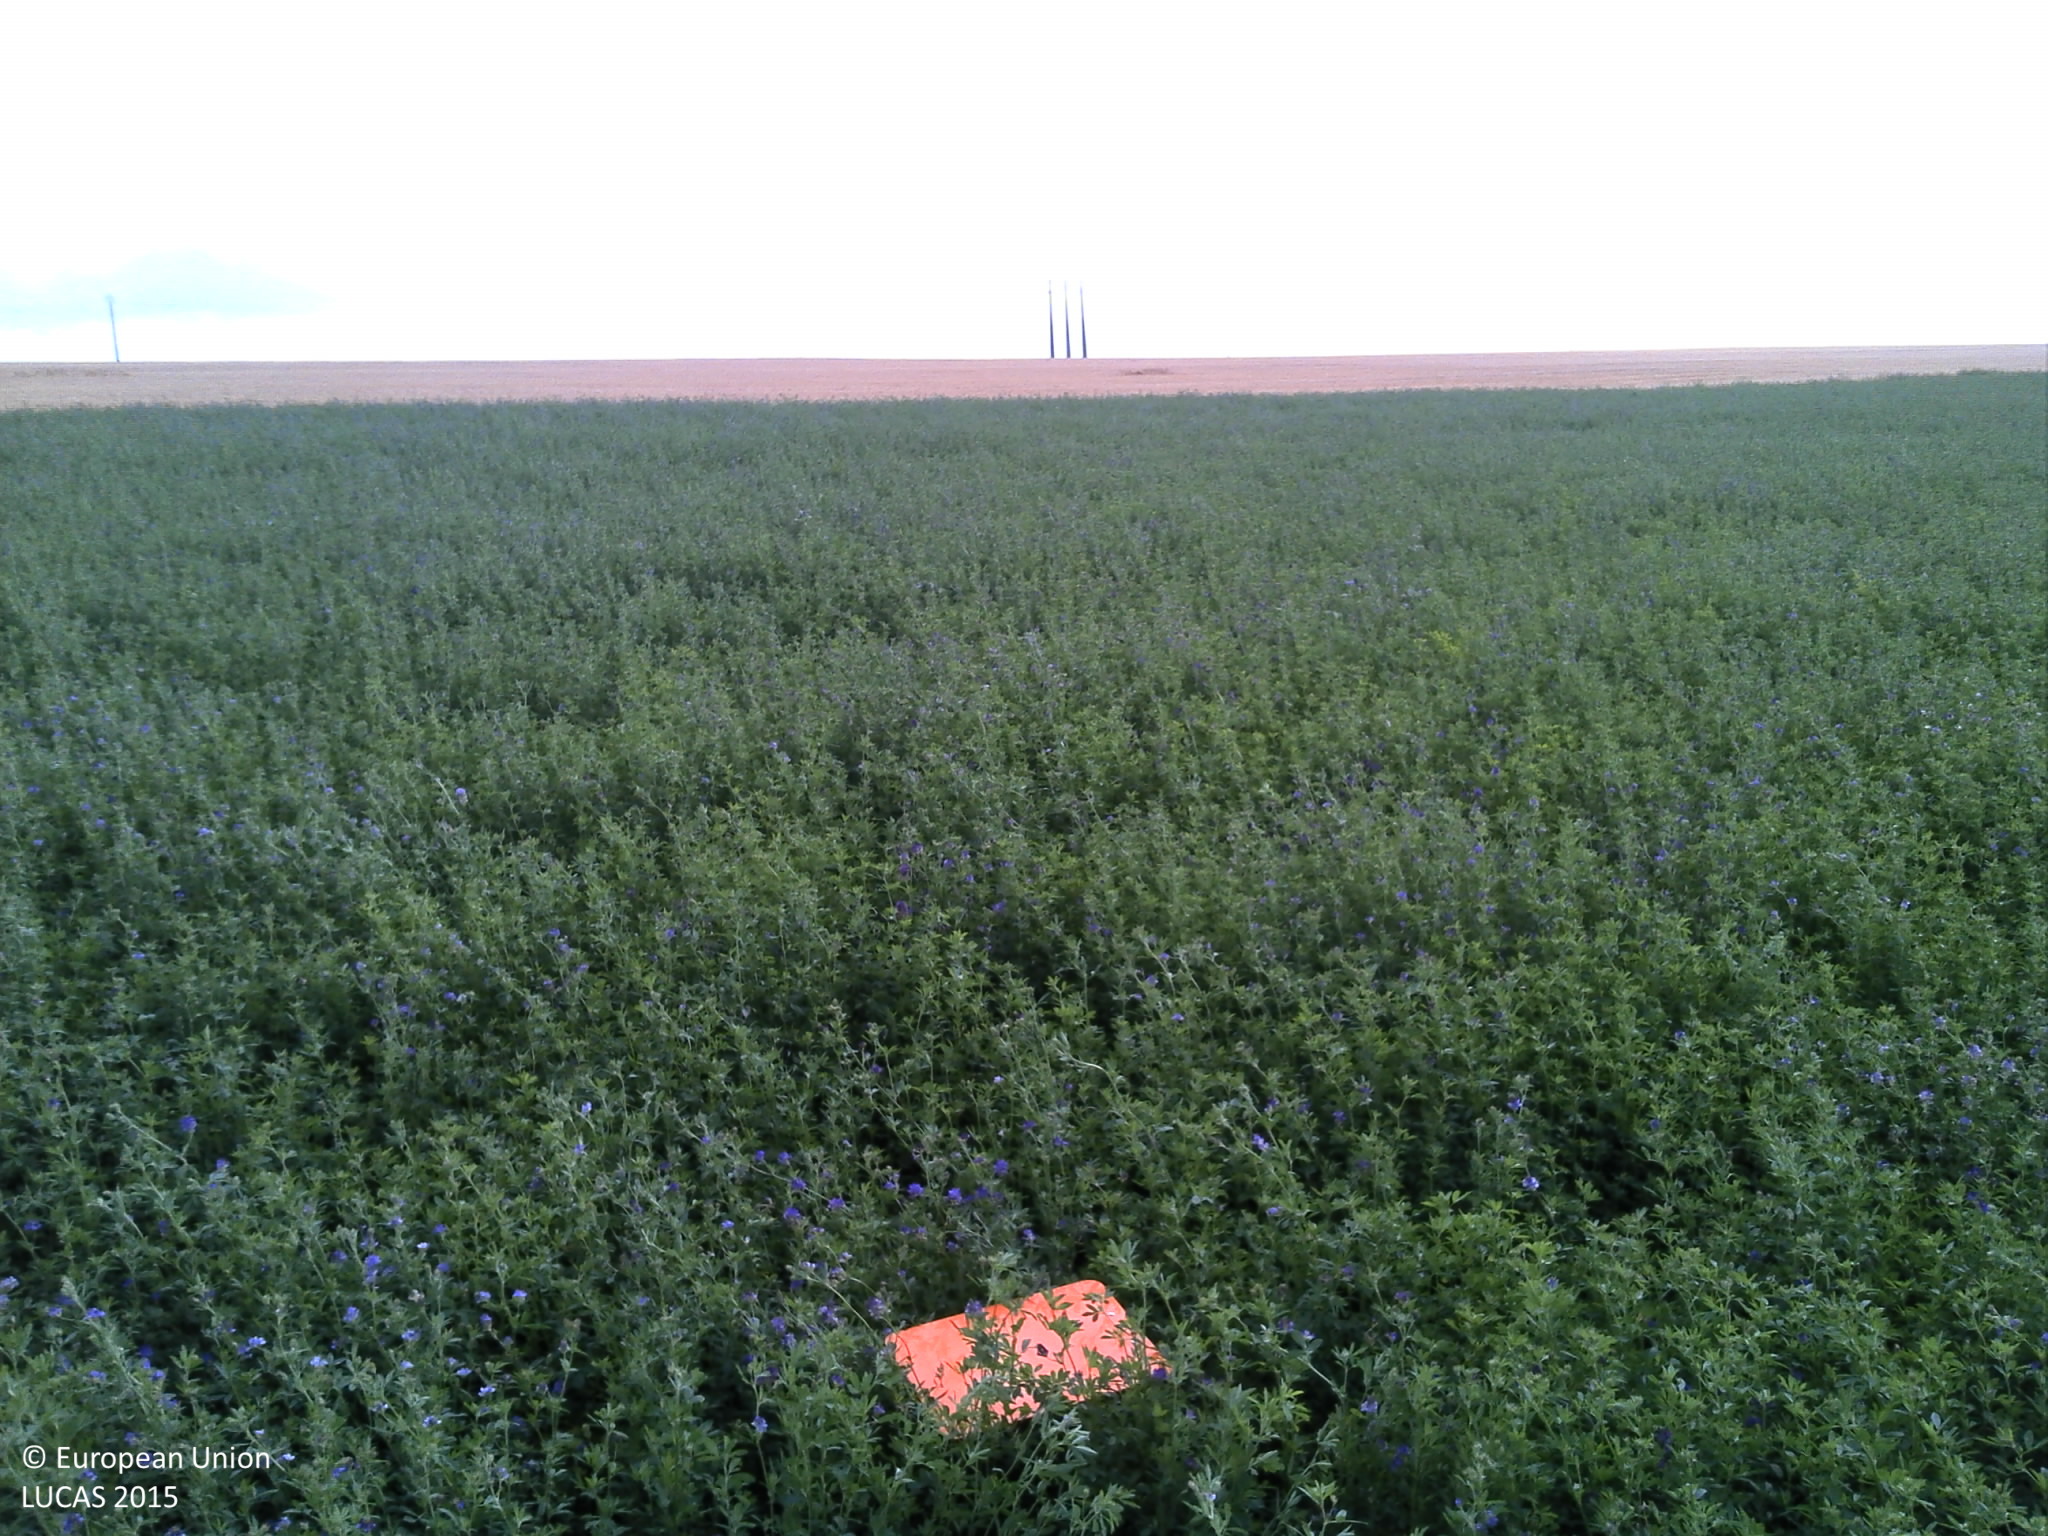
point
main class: Cropland
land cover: Lucerne
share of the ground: > 75 %
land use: Agriculture (excluding fallow land and kitchen gardens)
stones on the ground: < 10 %
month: July
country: FR
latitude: 49.2849
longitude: 4.6765
